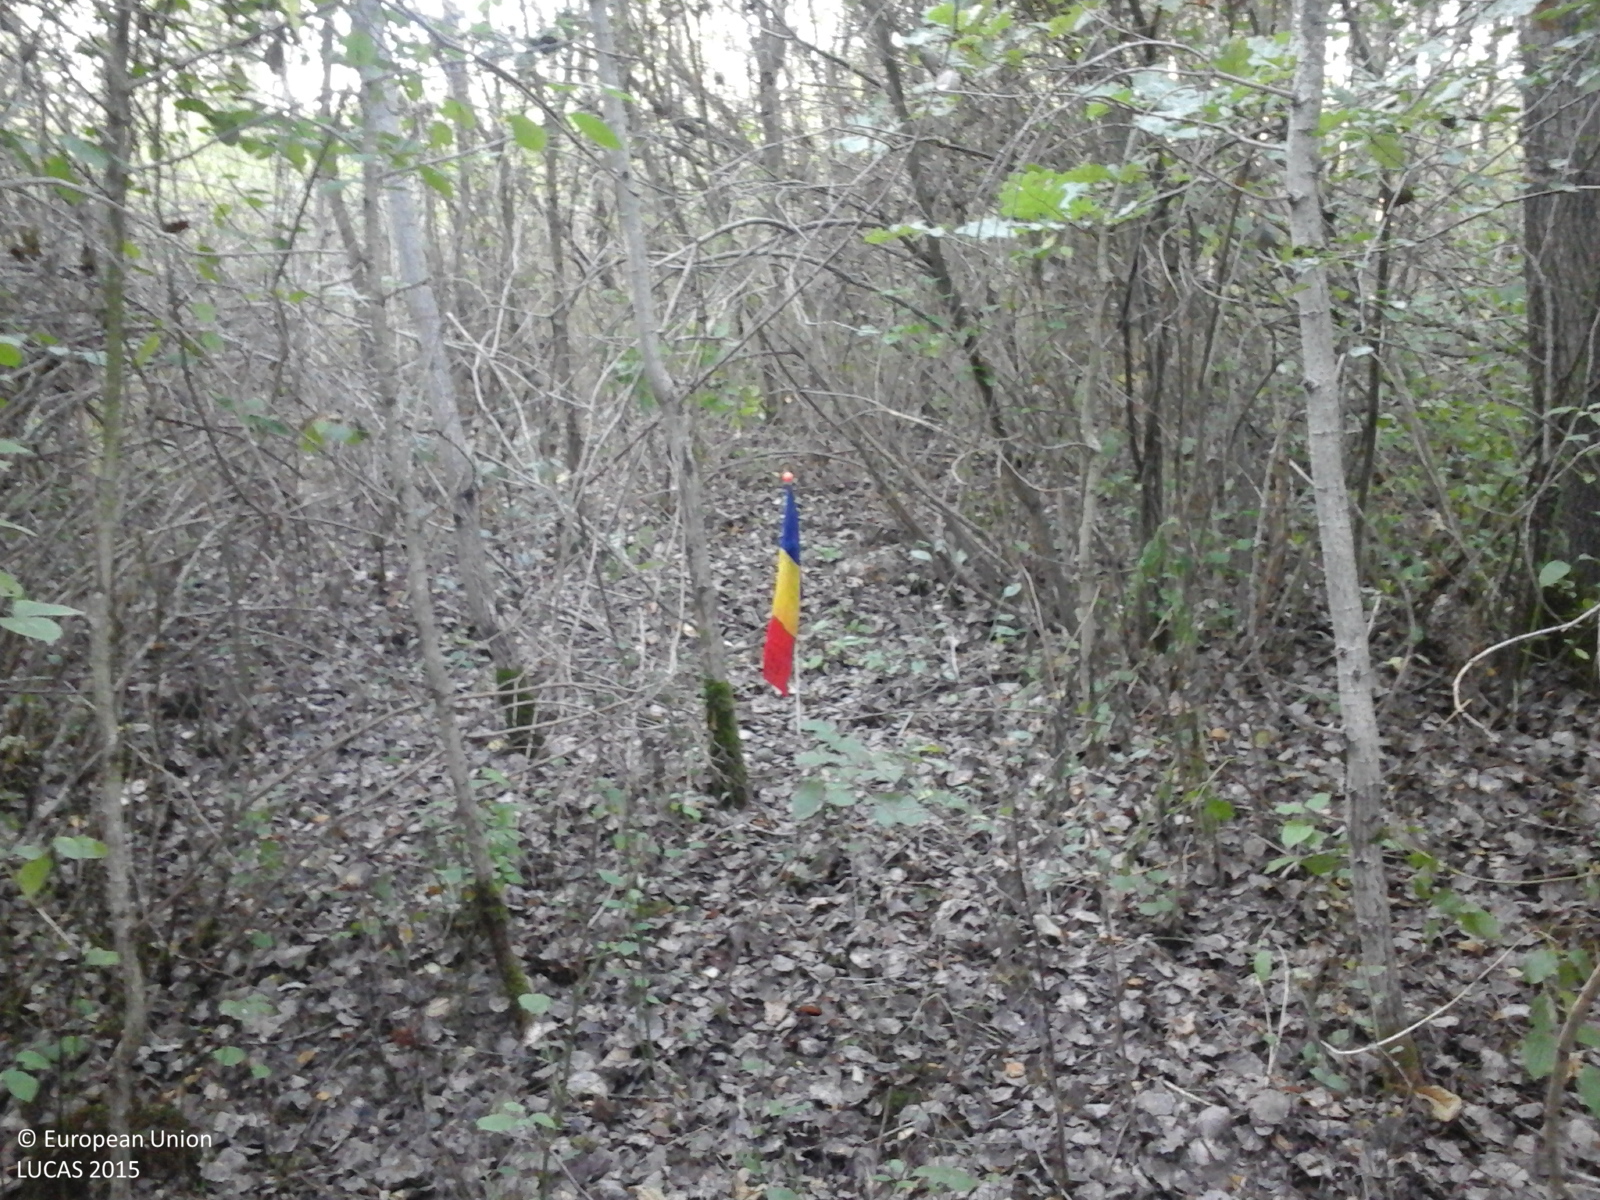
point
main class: Woodland
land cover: Broadleaved woodland
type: non-riverine alder, birch or aspen forest
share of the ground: > 75 %
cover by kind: broadleaved forest trees 100 %
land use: Forestry
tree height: > 5 m
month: September
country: RO
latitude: 45.4554
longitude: 22.1500
